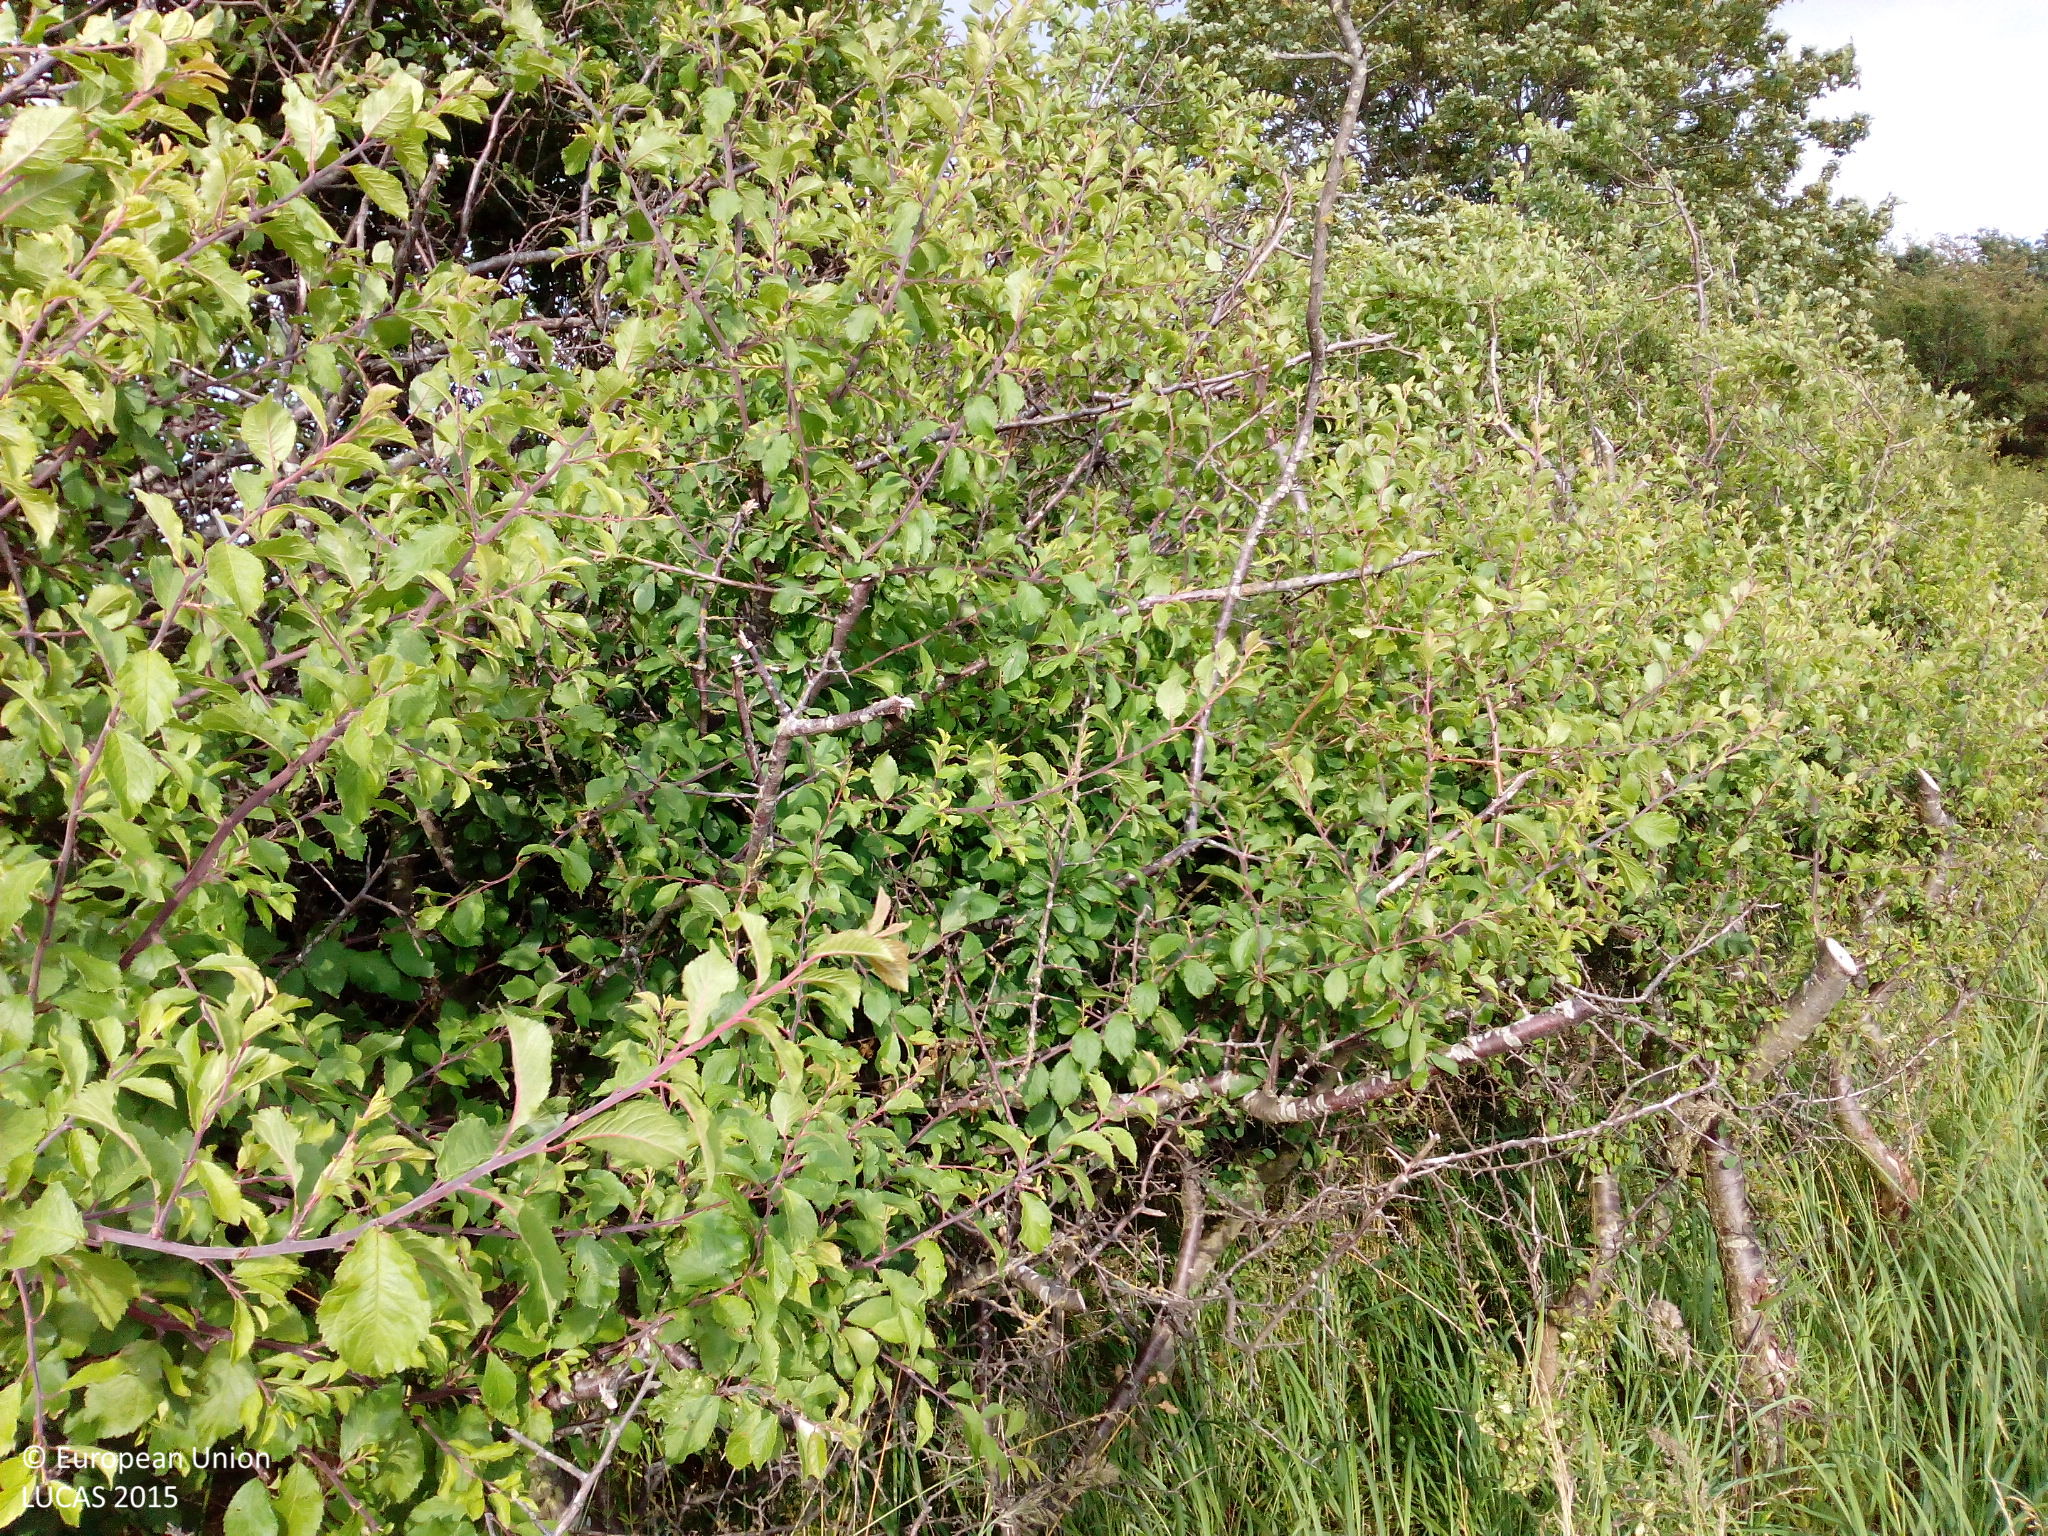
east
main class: Cropland
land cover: Barley
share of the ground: > 75 %
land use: Agriculture (excluding fallow land and kitchen gardens)
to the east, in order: Barley; Grassland without tree/shrub cover; Barley; Grass margins; Broadleaved woodland; Grassland without tree/shrub cover
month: July
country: DK
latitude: 55.8372
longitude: 11.5154
